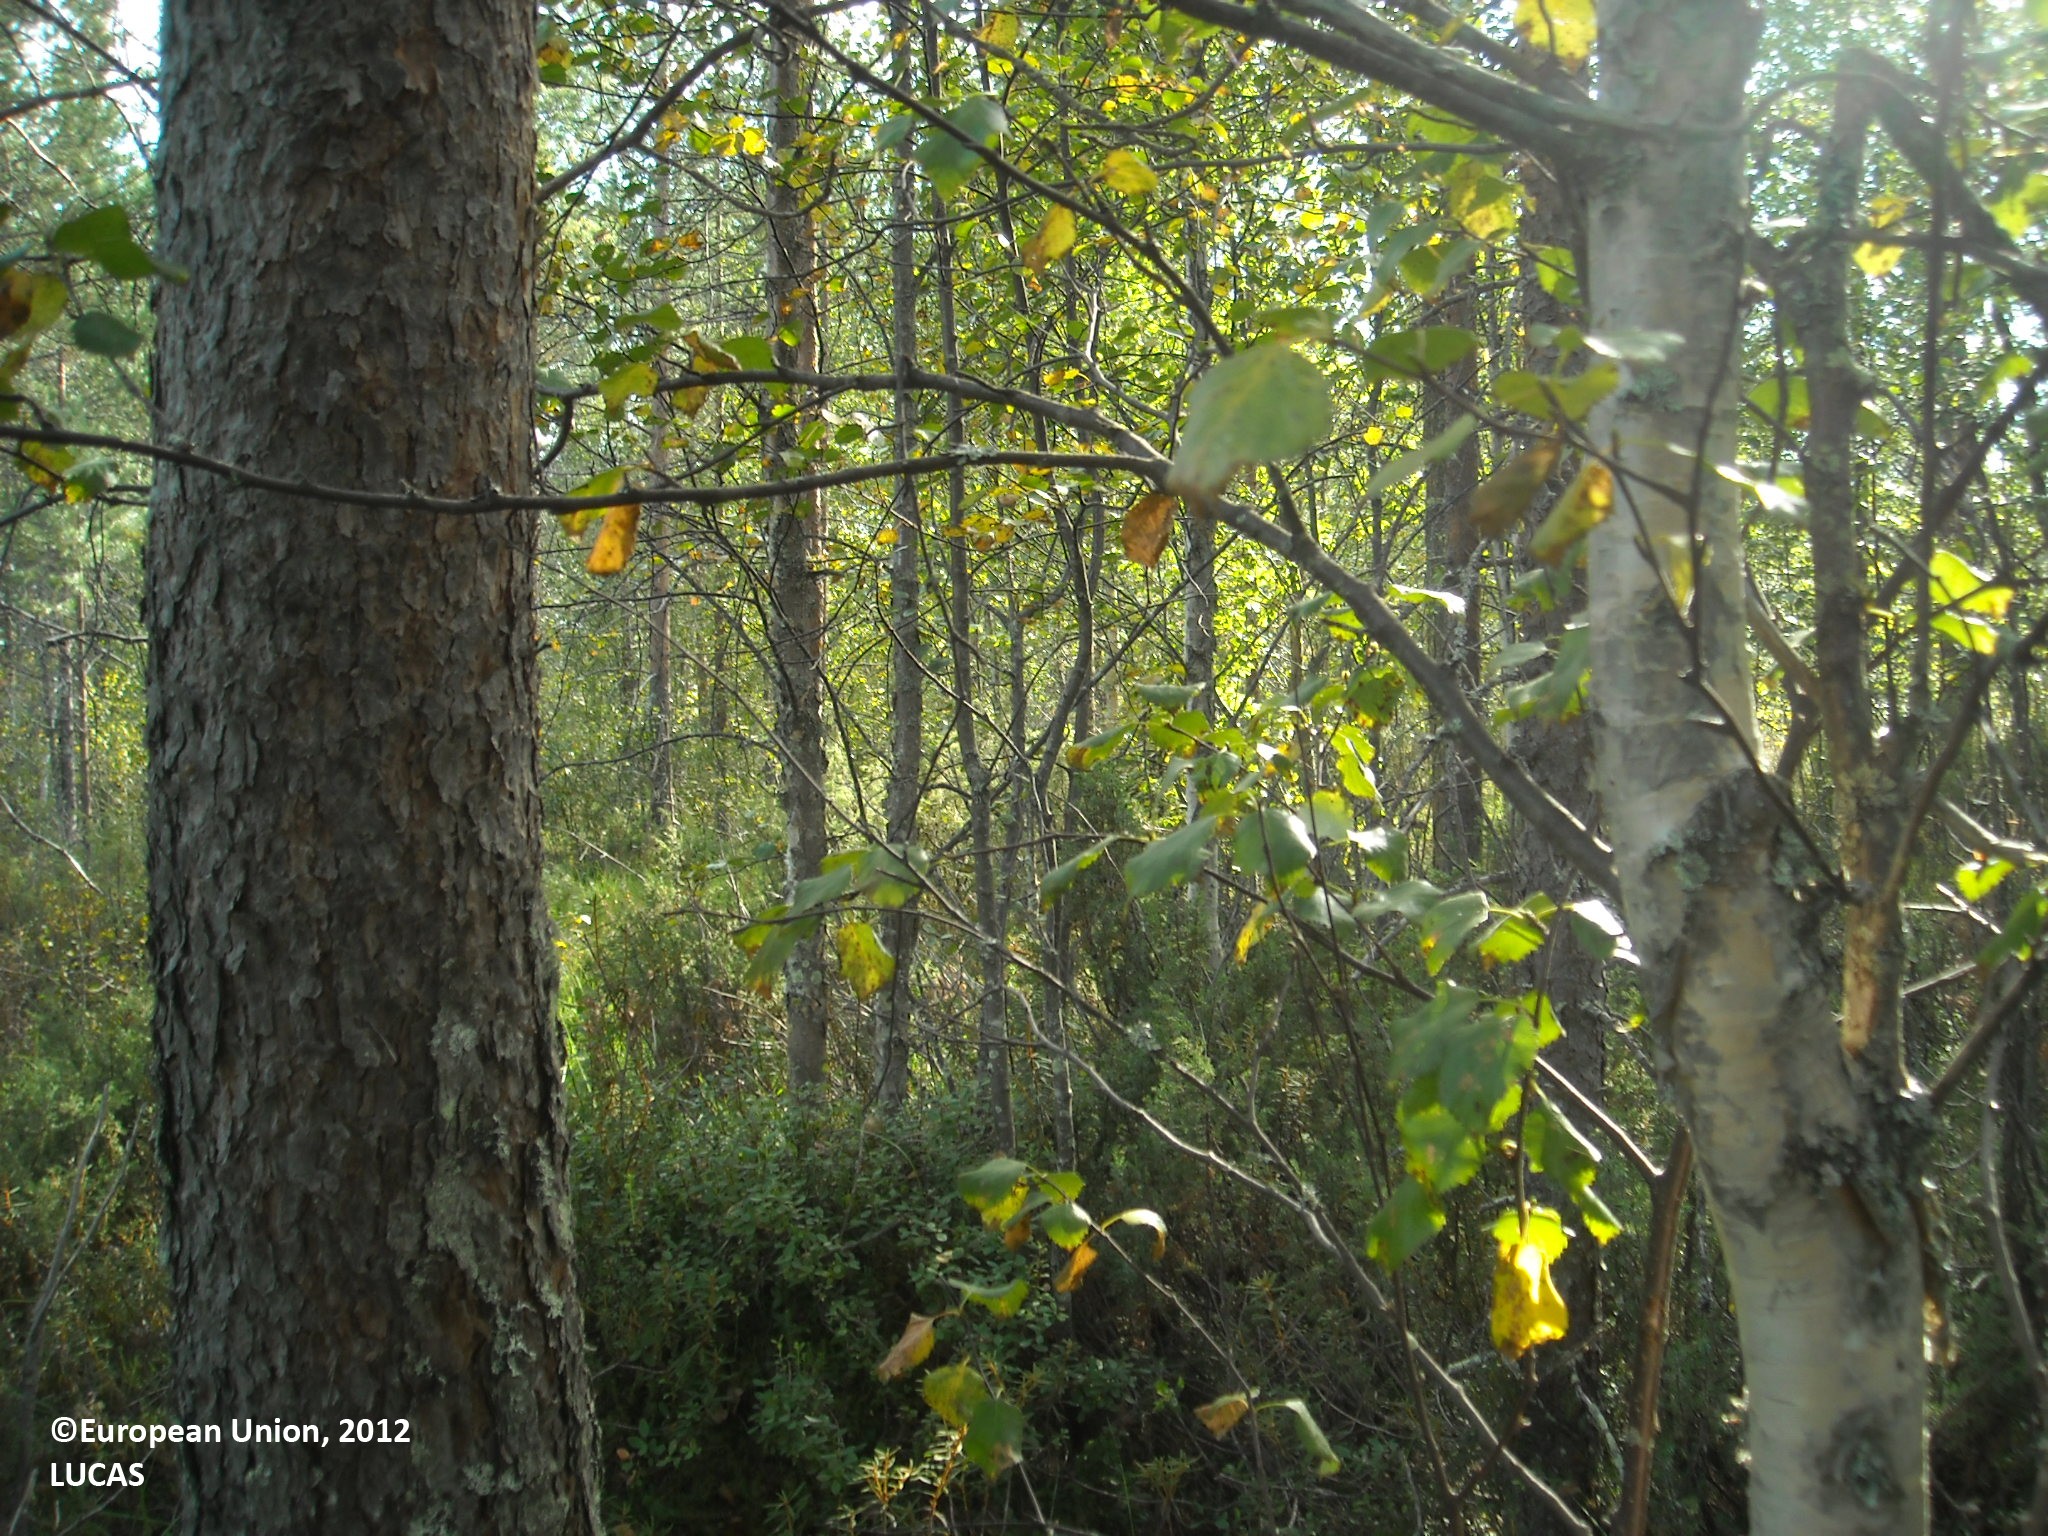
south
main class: Woodland
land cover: Pine dominated mixed woodland
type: boreal forest
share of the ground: > 75 %
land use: Forestry
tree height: > 5 m
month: August
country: FI
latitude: 65.3824
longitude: 27.7149
